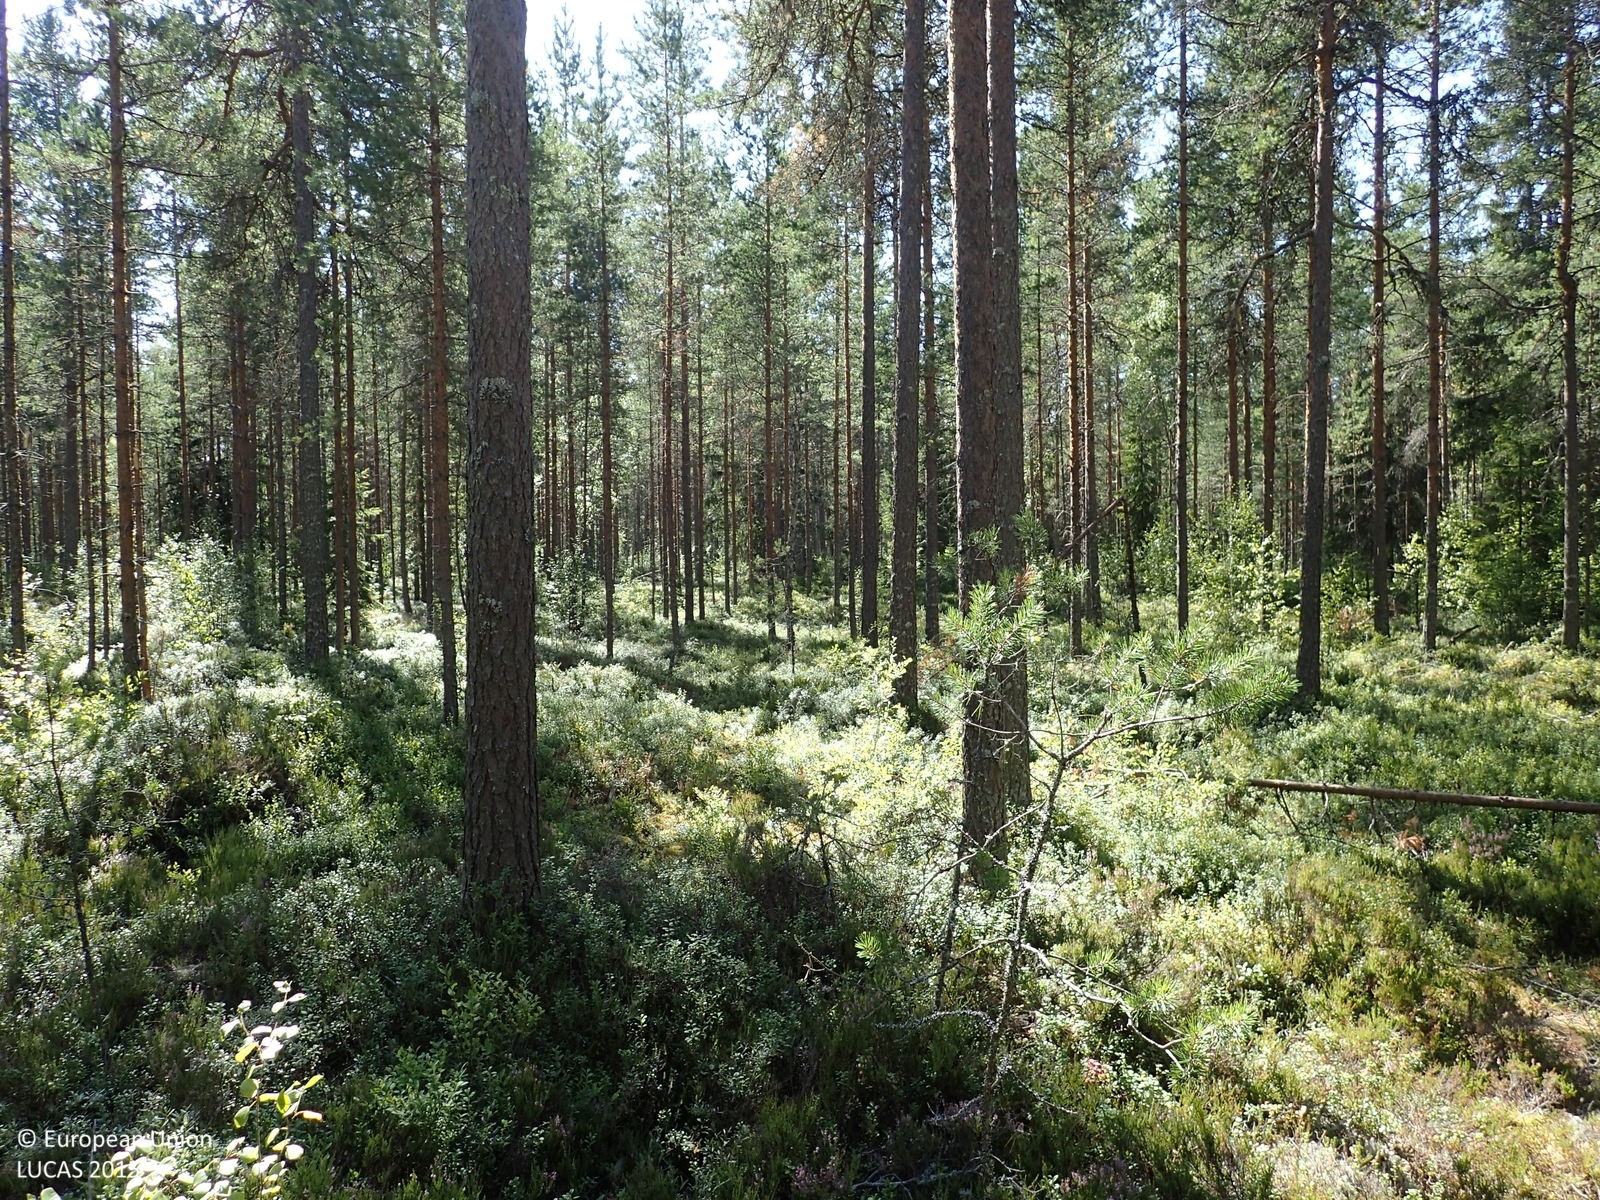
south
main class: Woodland
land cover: Pine dominated coniferous woodland
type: boreal forest
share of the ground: 50 - 75 %
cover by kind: coniferous forest trees 60 %, shrubs 25 %, broadleaved forest trees 10 %, lichens and mosses 5 %
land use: Forestry
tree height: > 5 m
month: August
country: FI
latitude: 62.5919
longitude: 21.9455
